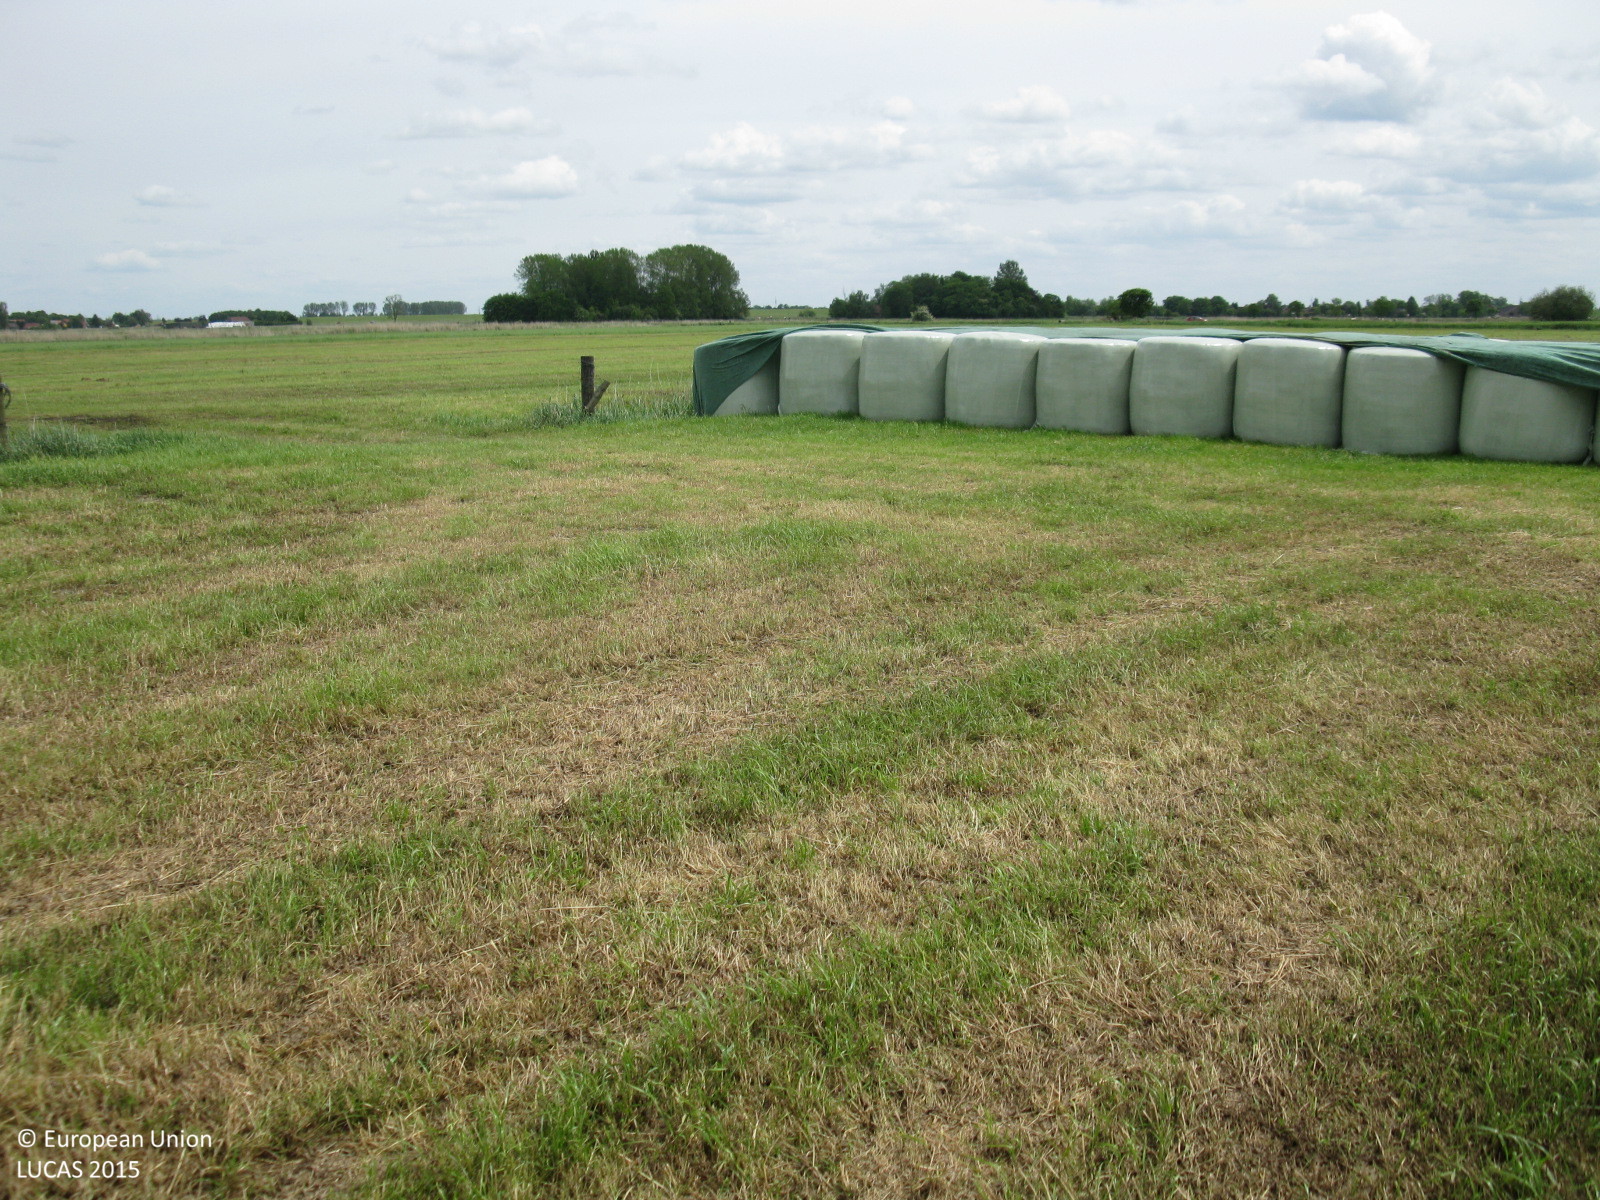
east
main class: Grassland
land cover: Grassland without tree/shrub cover
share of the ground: > 75 %
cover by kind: herbaceous plants 100 %
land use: Agriculture (excluding fallow land and kitchen gardens)
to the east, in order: Grassland without tree/shrub cover; Ditches and canals; Grassland without tree/shrub cover; Ditches and canals; Grass margins; Tracks; Grassland without tree/shrub cover
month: June
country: DE
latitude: 53.1938
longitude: 7.3812
